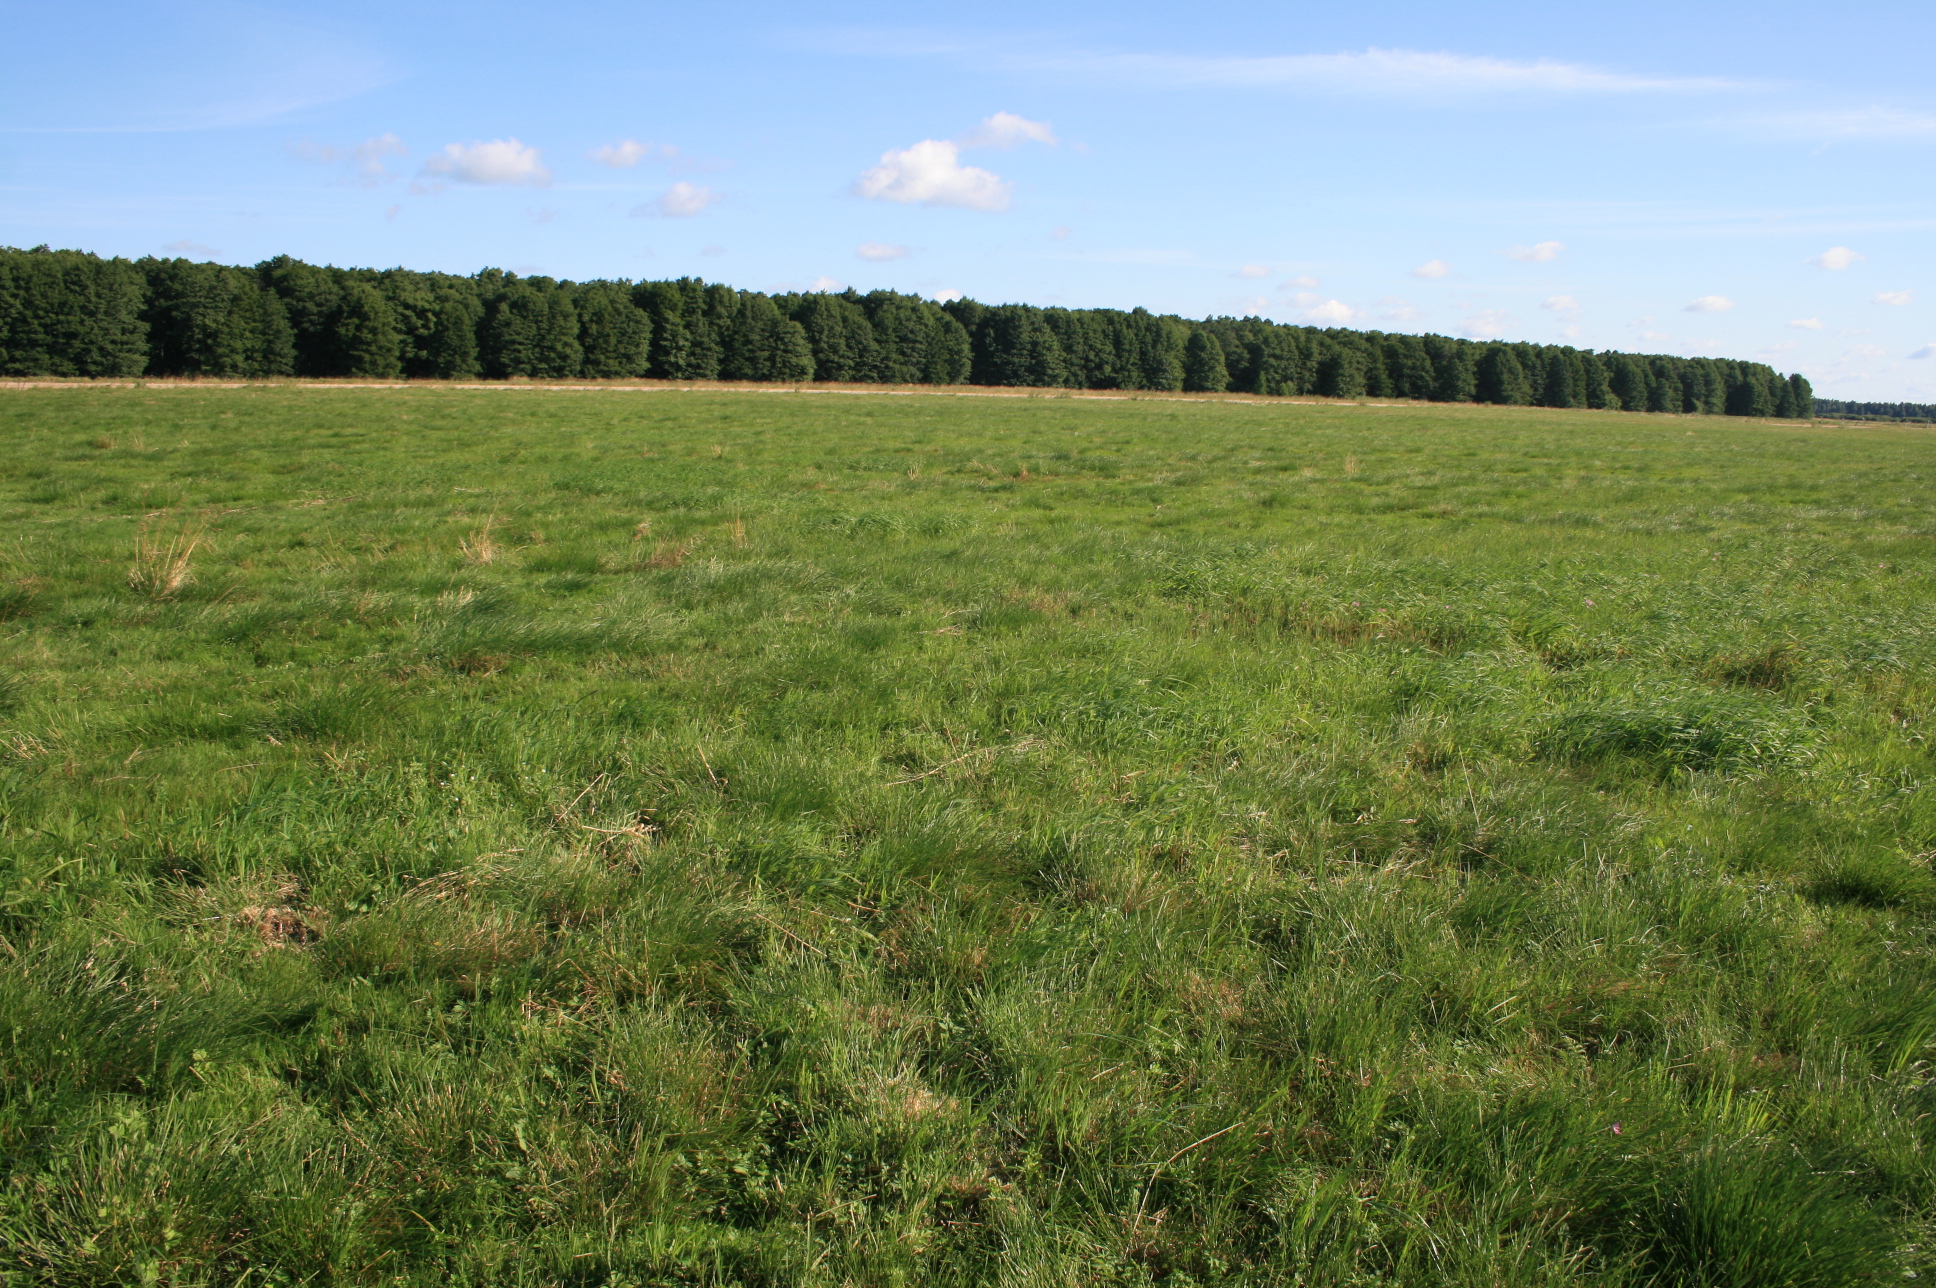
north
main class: Grassland
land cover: Grassland without tree/shrub cover
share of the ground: > 75 %
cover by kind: herbaceous plants 100 %
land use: Agriculture (excluding fallow land and kitchen gardens)
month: July
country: LT
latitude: 55.3783
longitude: 21.2960
